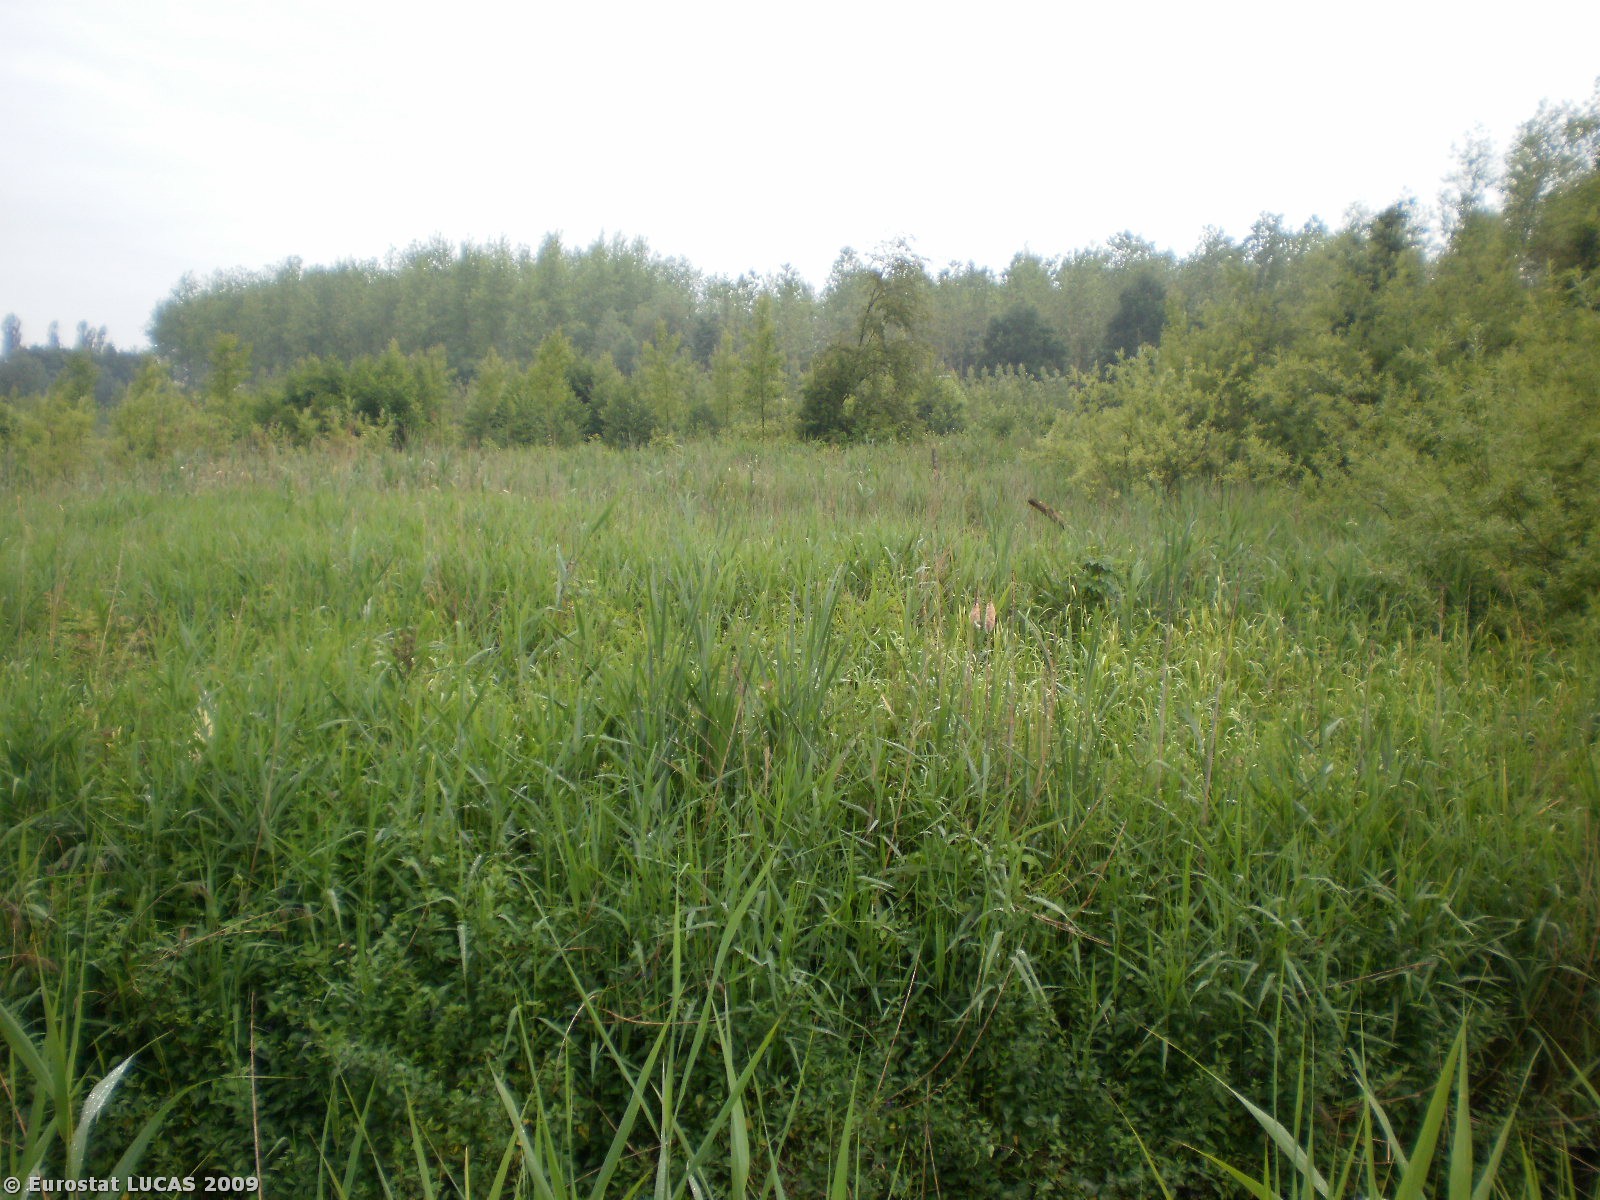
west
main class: Grassland
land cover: Grassland with sparse tree/shrub cover
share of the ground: > 75 %
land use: Nature reserves
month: June
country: BE
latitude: 51.0814
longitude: 4.1849
